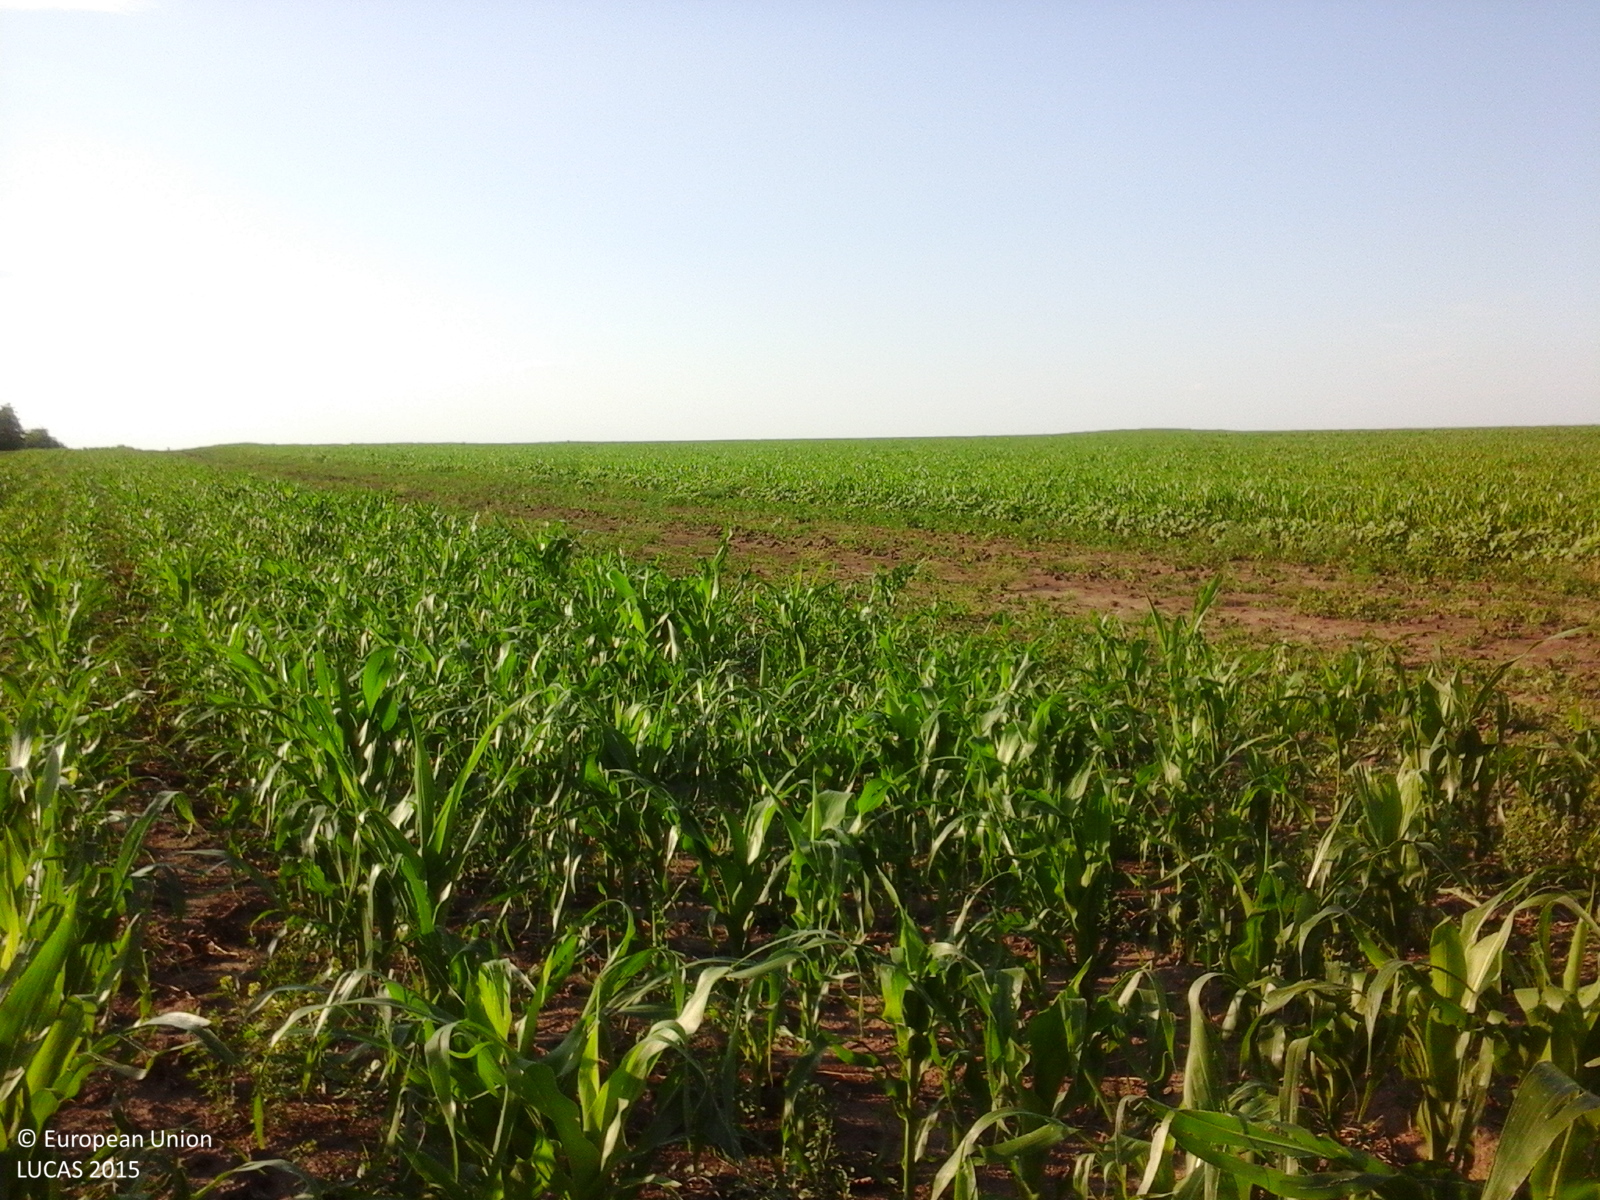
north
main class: Cropland
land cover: Maize
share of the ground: 50 - 75 %
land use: Agriculture (excluding fallow land and kitchen gardens)
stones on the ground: < 10 %
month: June
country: RO
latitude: 47.8344
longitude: 26.4833
